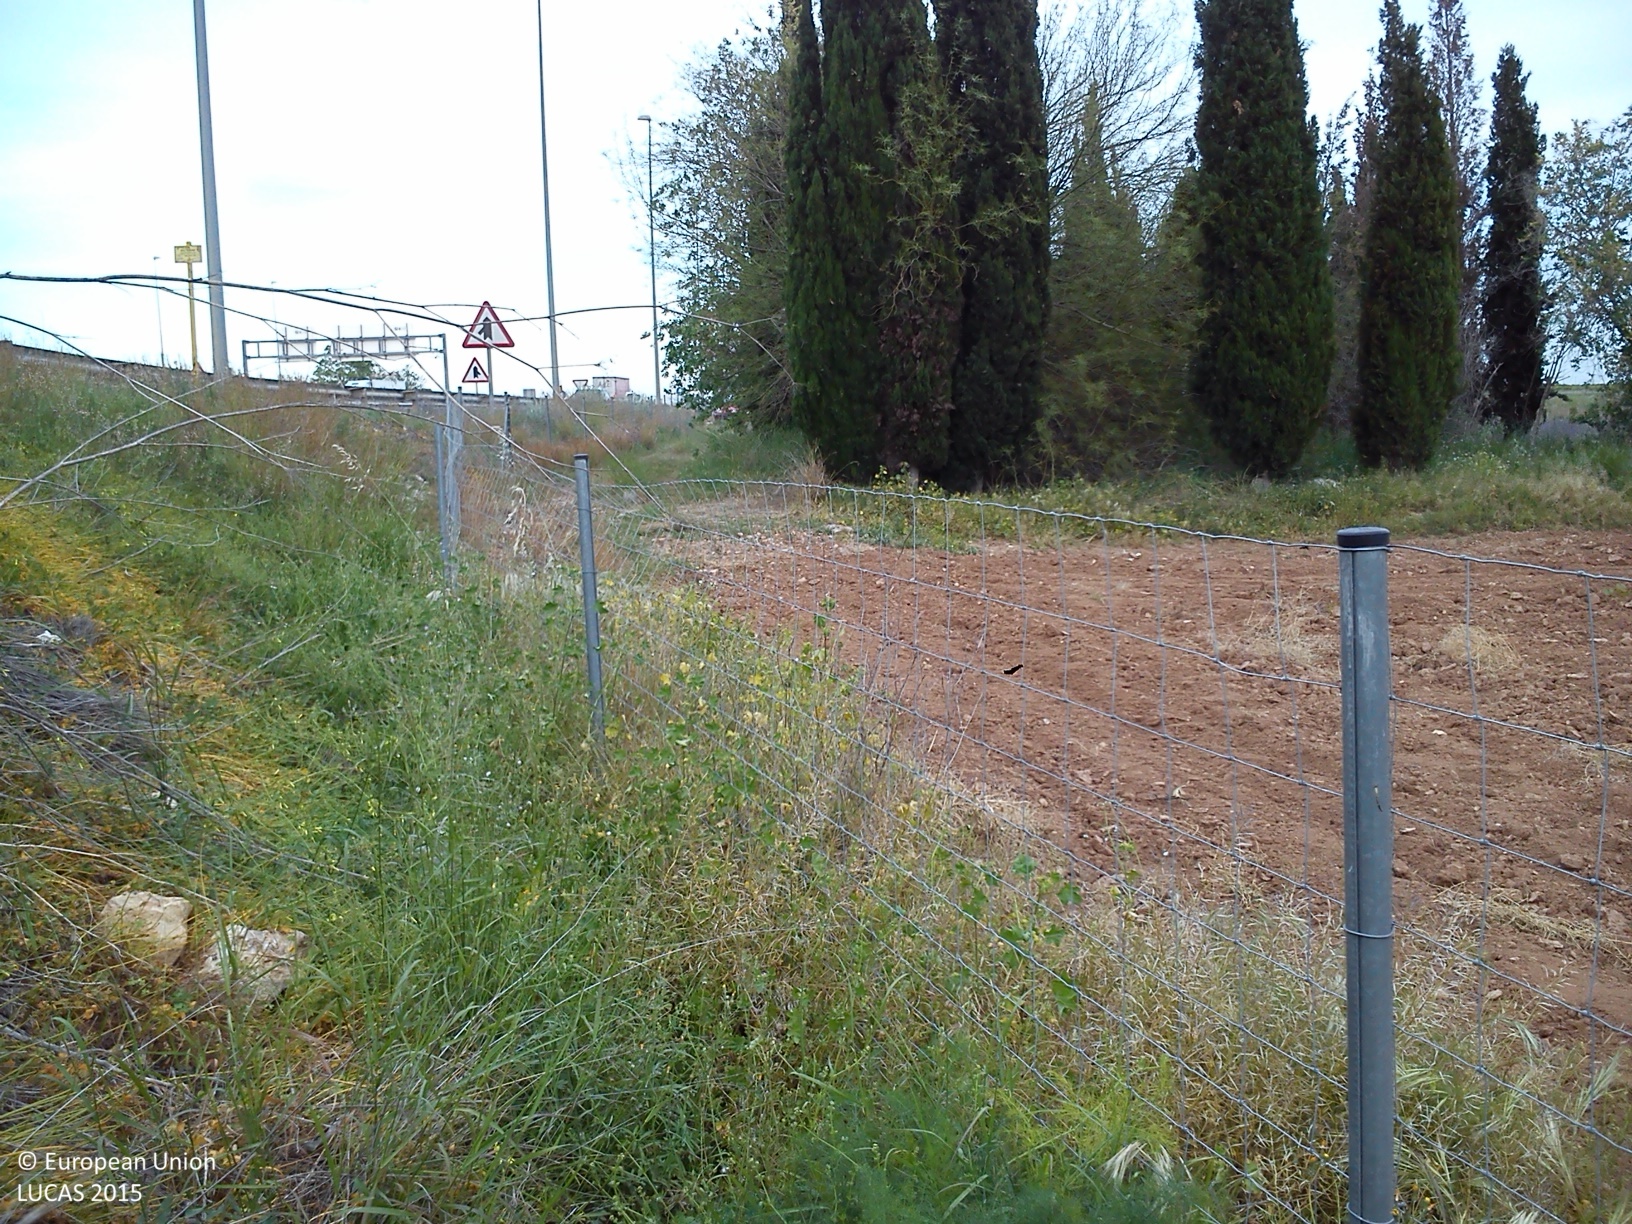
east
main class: Shrubland
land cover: Shrubland without tree cover
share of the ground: > 75 %
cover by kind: herbaceous plants 65 %, shrubs 35 %
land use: Abandoned areas
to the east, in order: Shrubland without tree cover; Tracks; Paved roads, cycling and walking lanes; Fences; Shrubland without tree cover
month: April
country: ES
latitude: 39.4738
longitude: -0.5883
